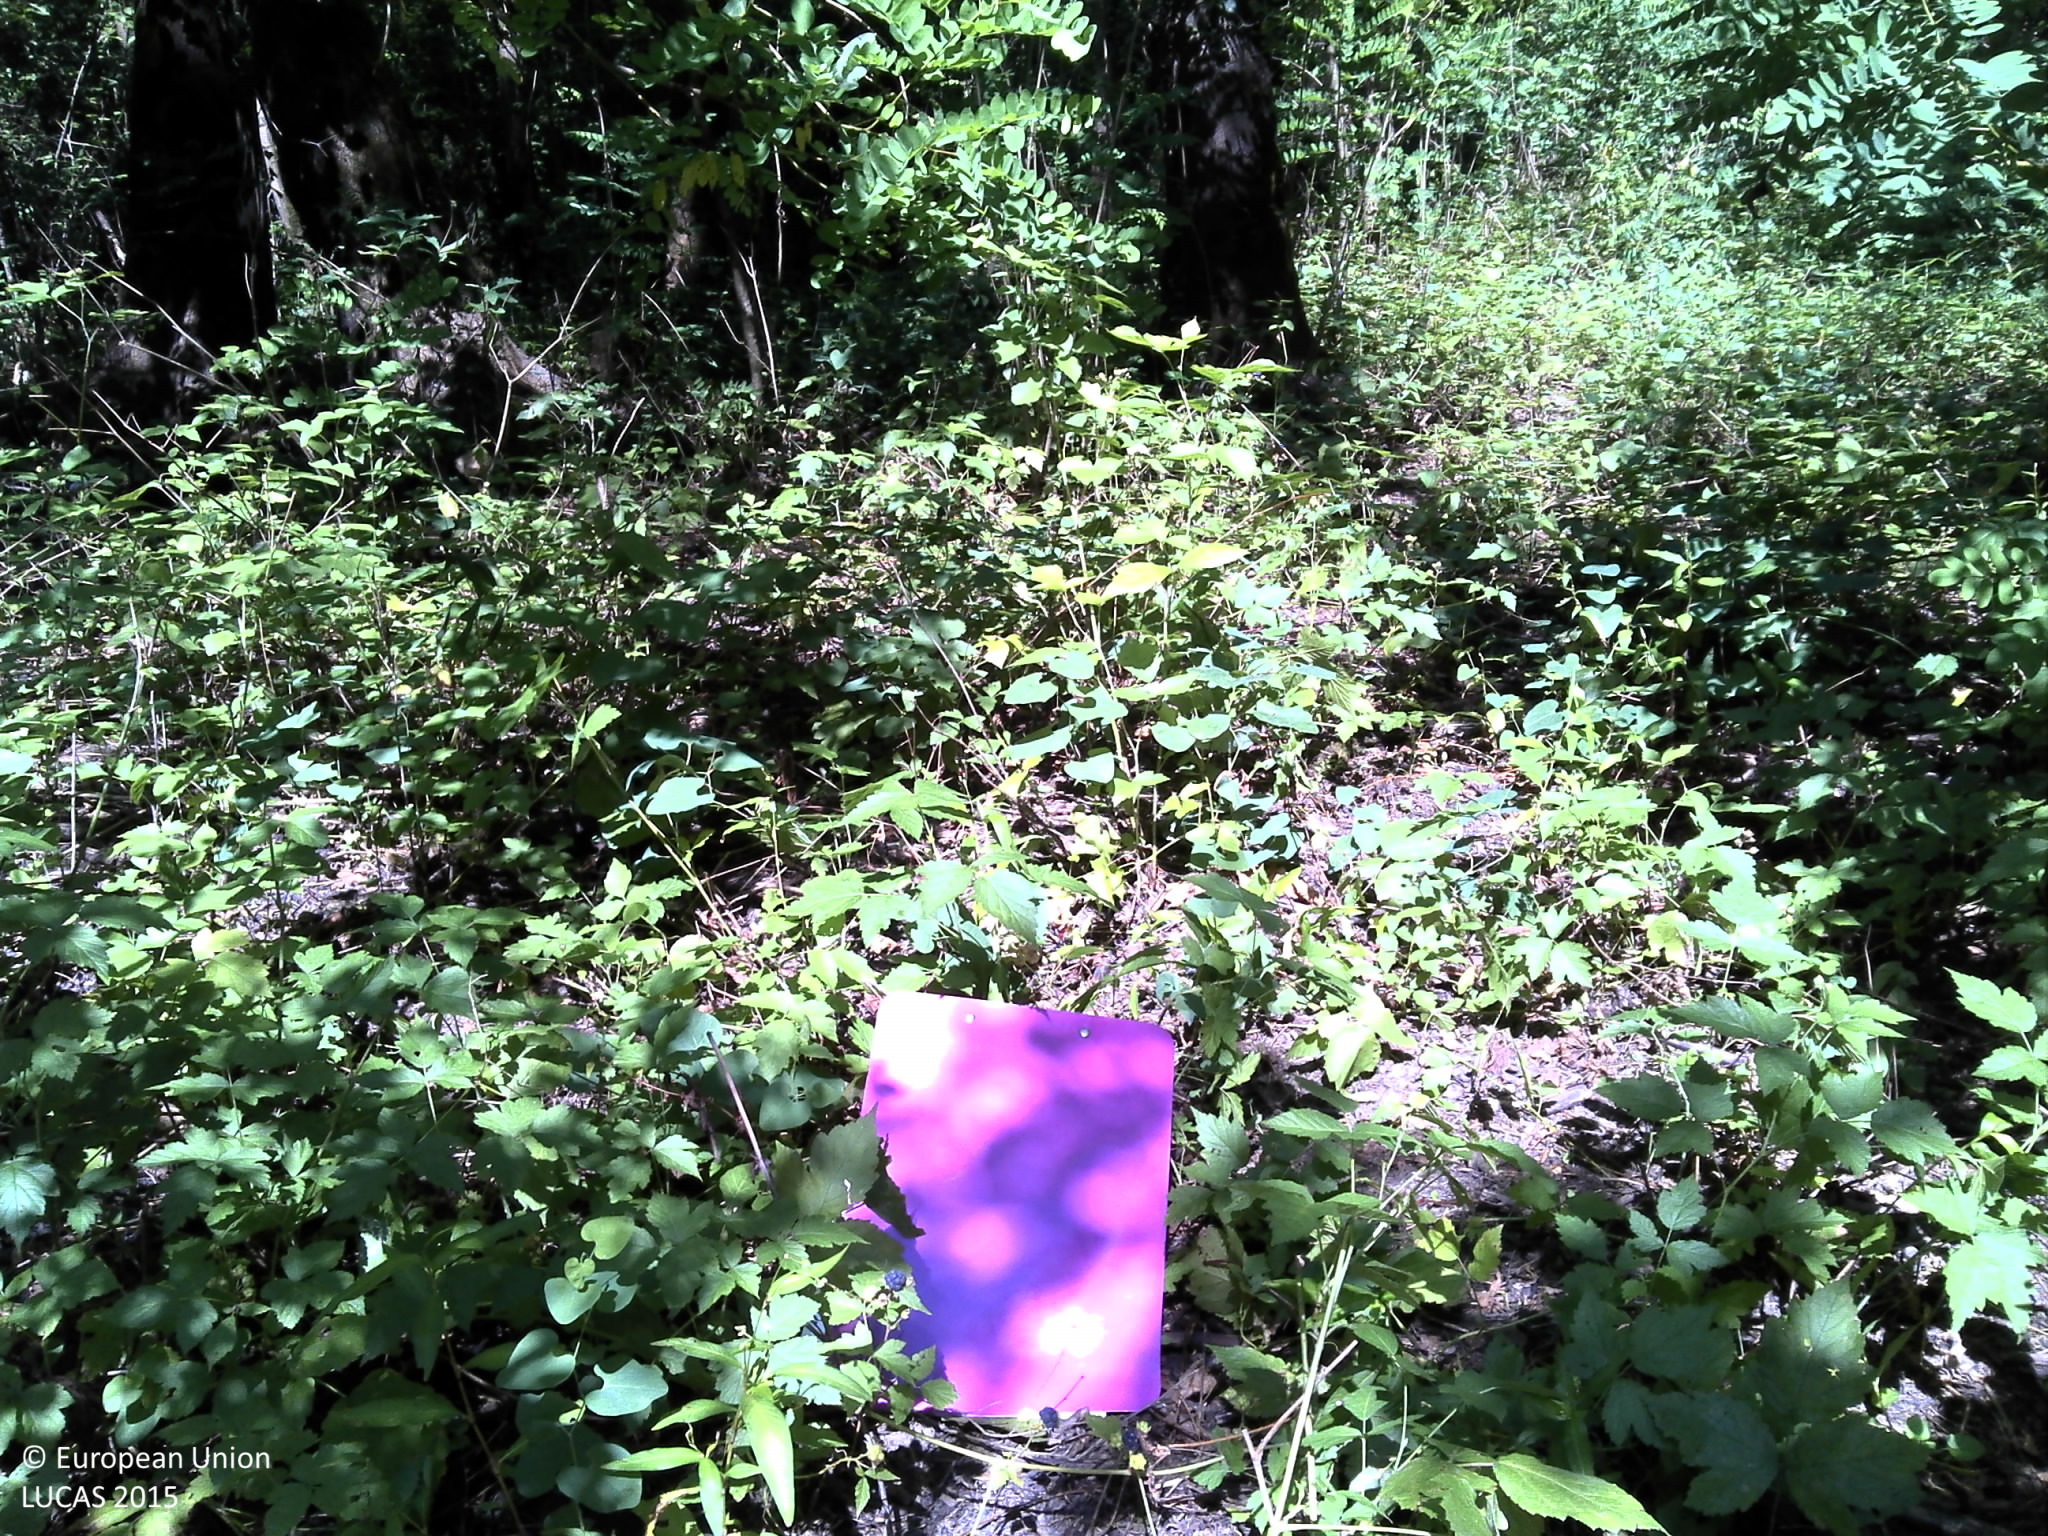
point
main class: Woodland
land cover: Broadleaved woodland
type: acidophilous oak and oak-birch forest
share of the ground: > 75 %
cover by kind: broadleaved forest trees 100 %
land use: Forestry
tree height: > 5 m
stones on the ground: < 10 %
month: August
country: HR
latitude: 45.4176
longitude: 16.7075
